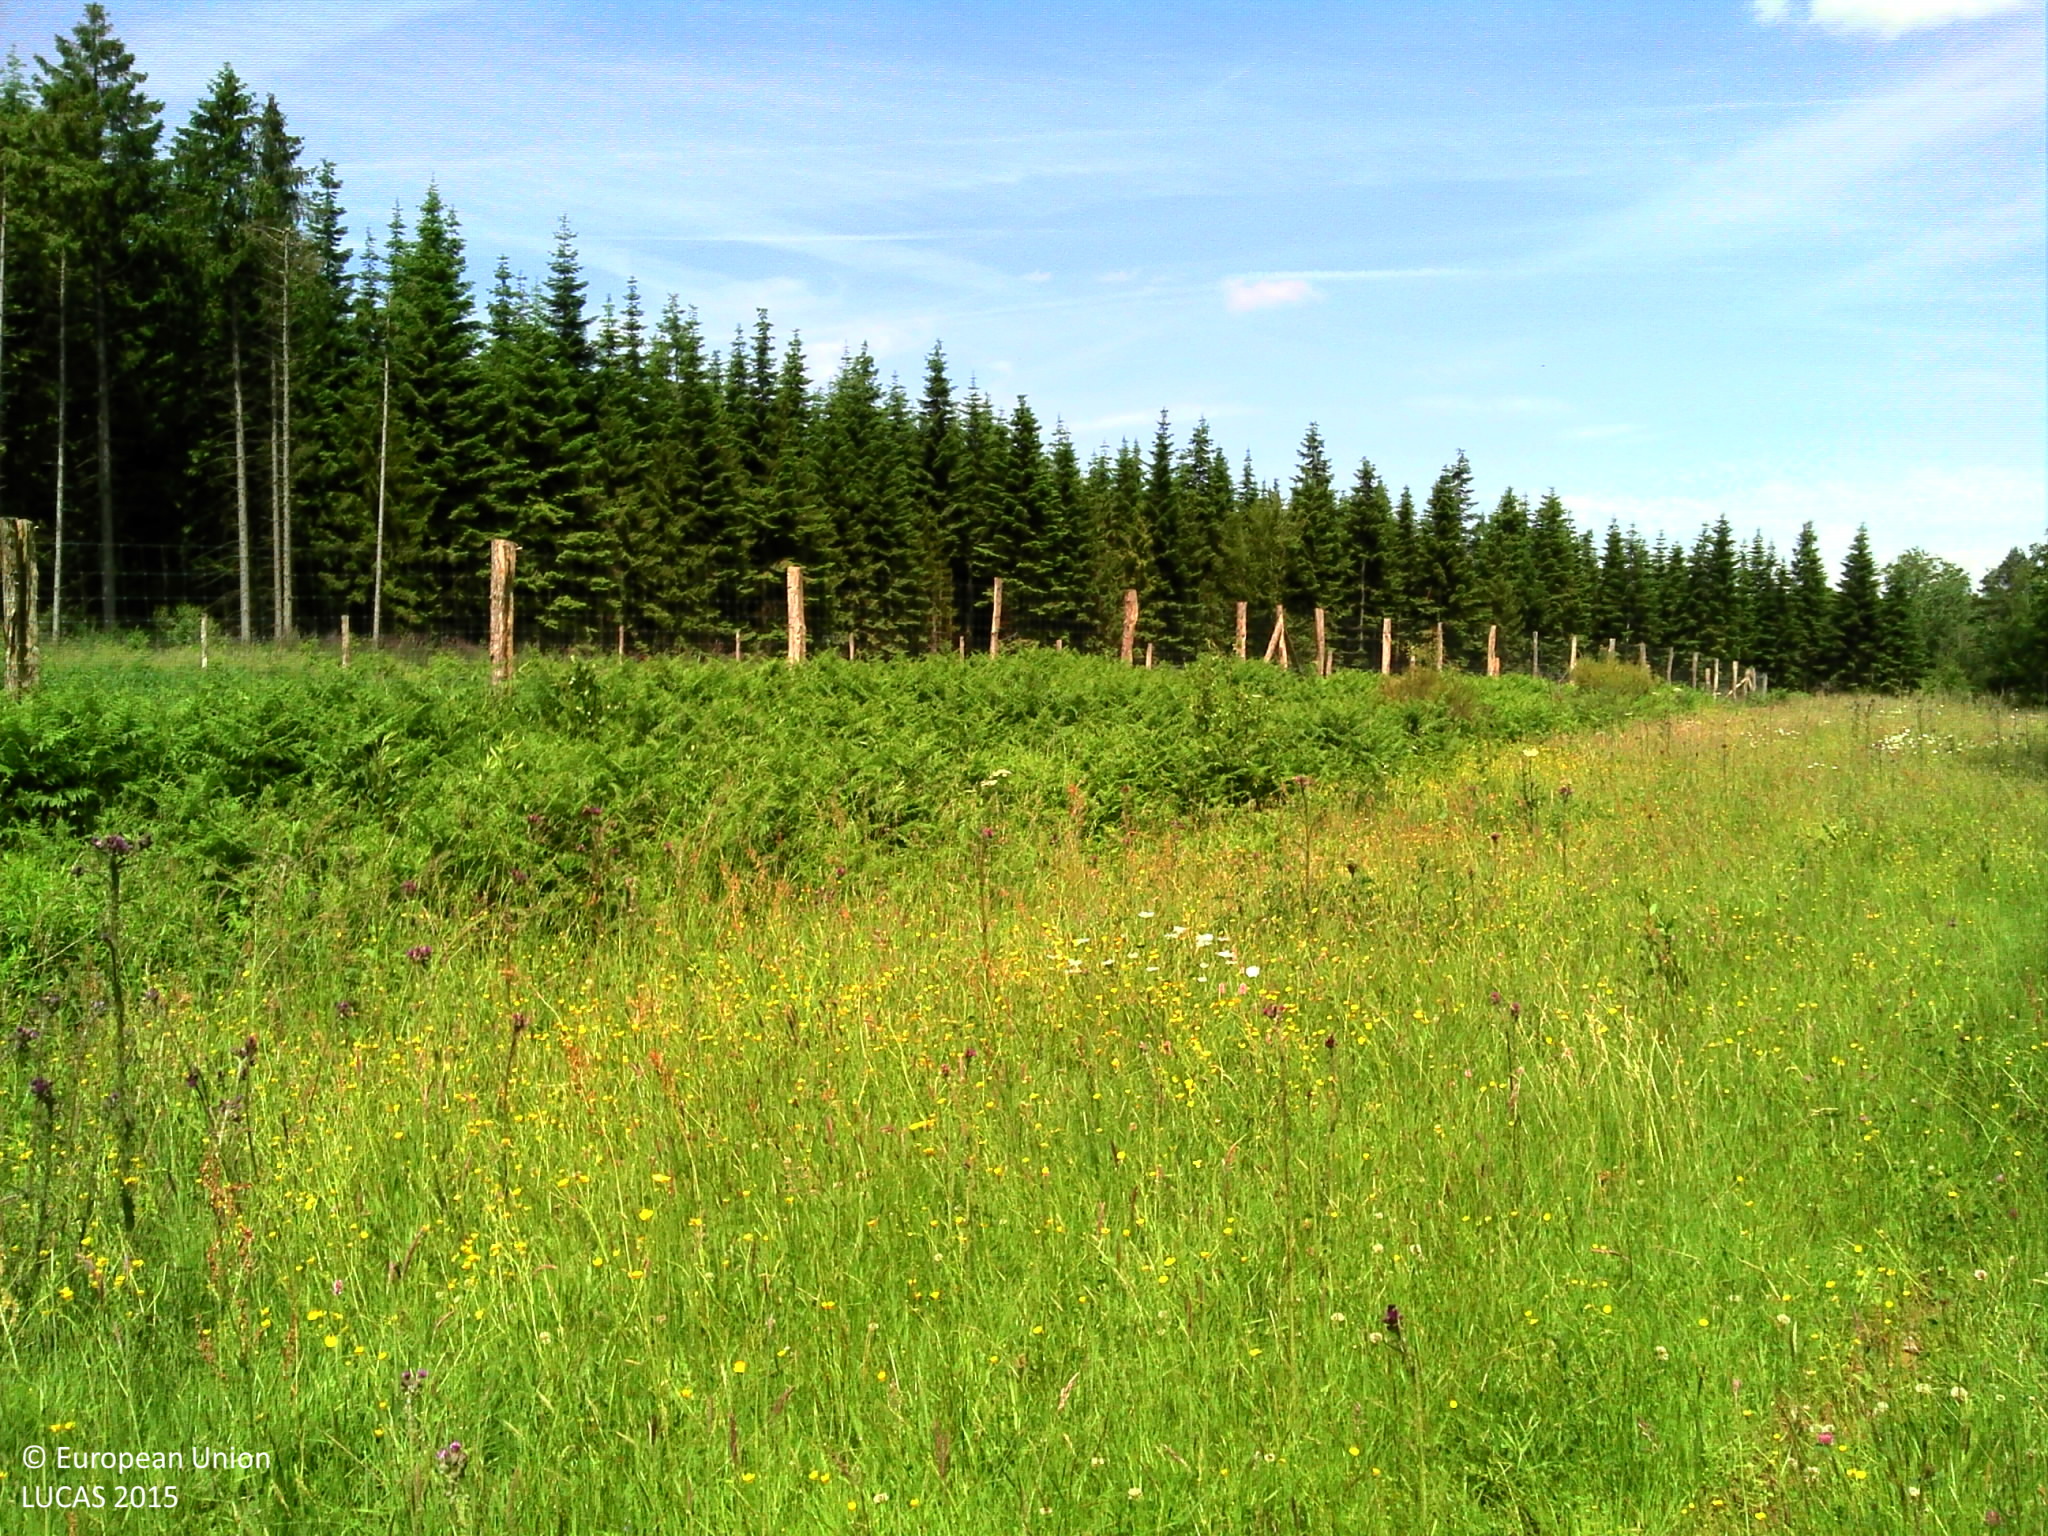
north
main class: Grassland
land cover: Spontaneously vegetated surfaces
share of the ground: > 75 %
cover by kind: herbaceous plants 100 %
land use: Forestry
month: June
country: BE
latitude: 49.9960
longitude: 5.2688
